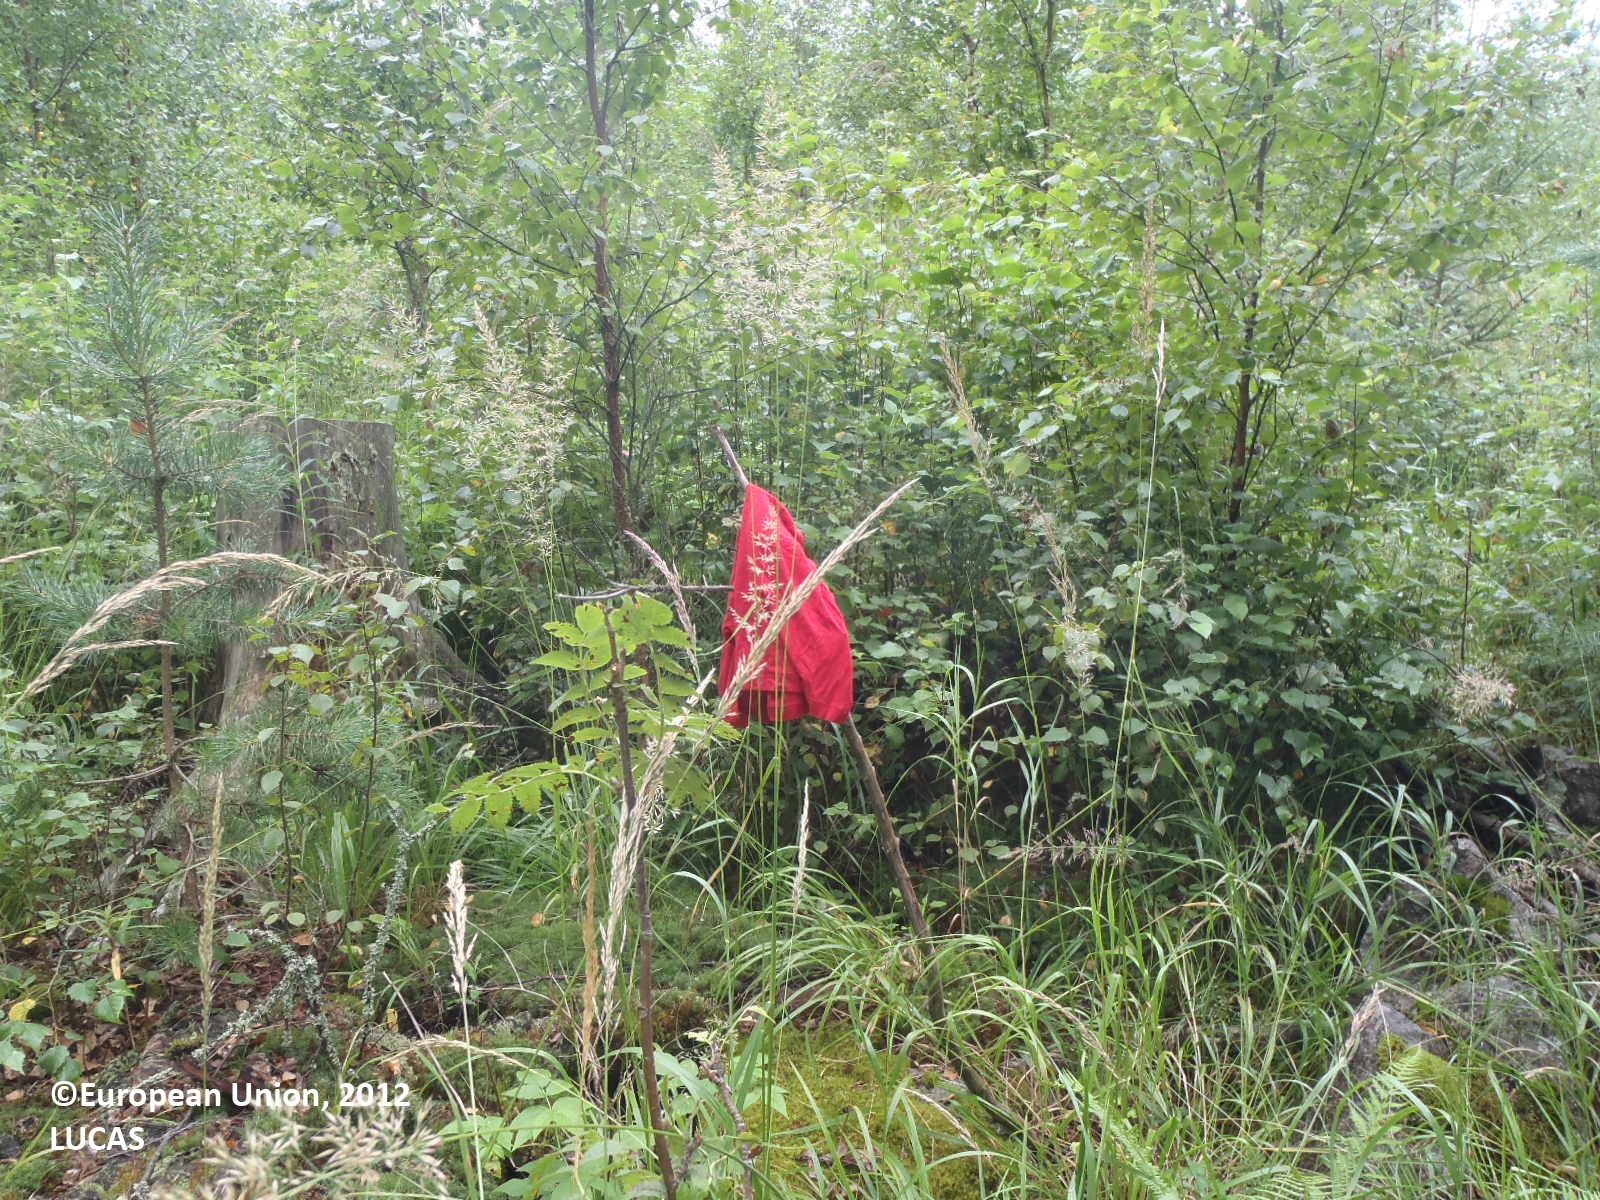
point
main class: Woodland
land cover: Other mixed woodland
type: boreal forest
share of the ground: > 75 %
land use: Forestry
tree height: > 5 m
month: July
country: FI
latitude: 60.7782
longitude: 21.7926
